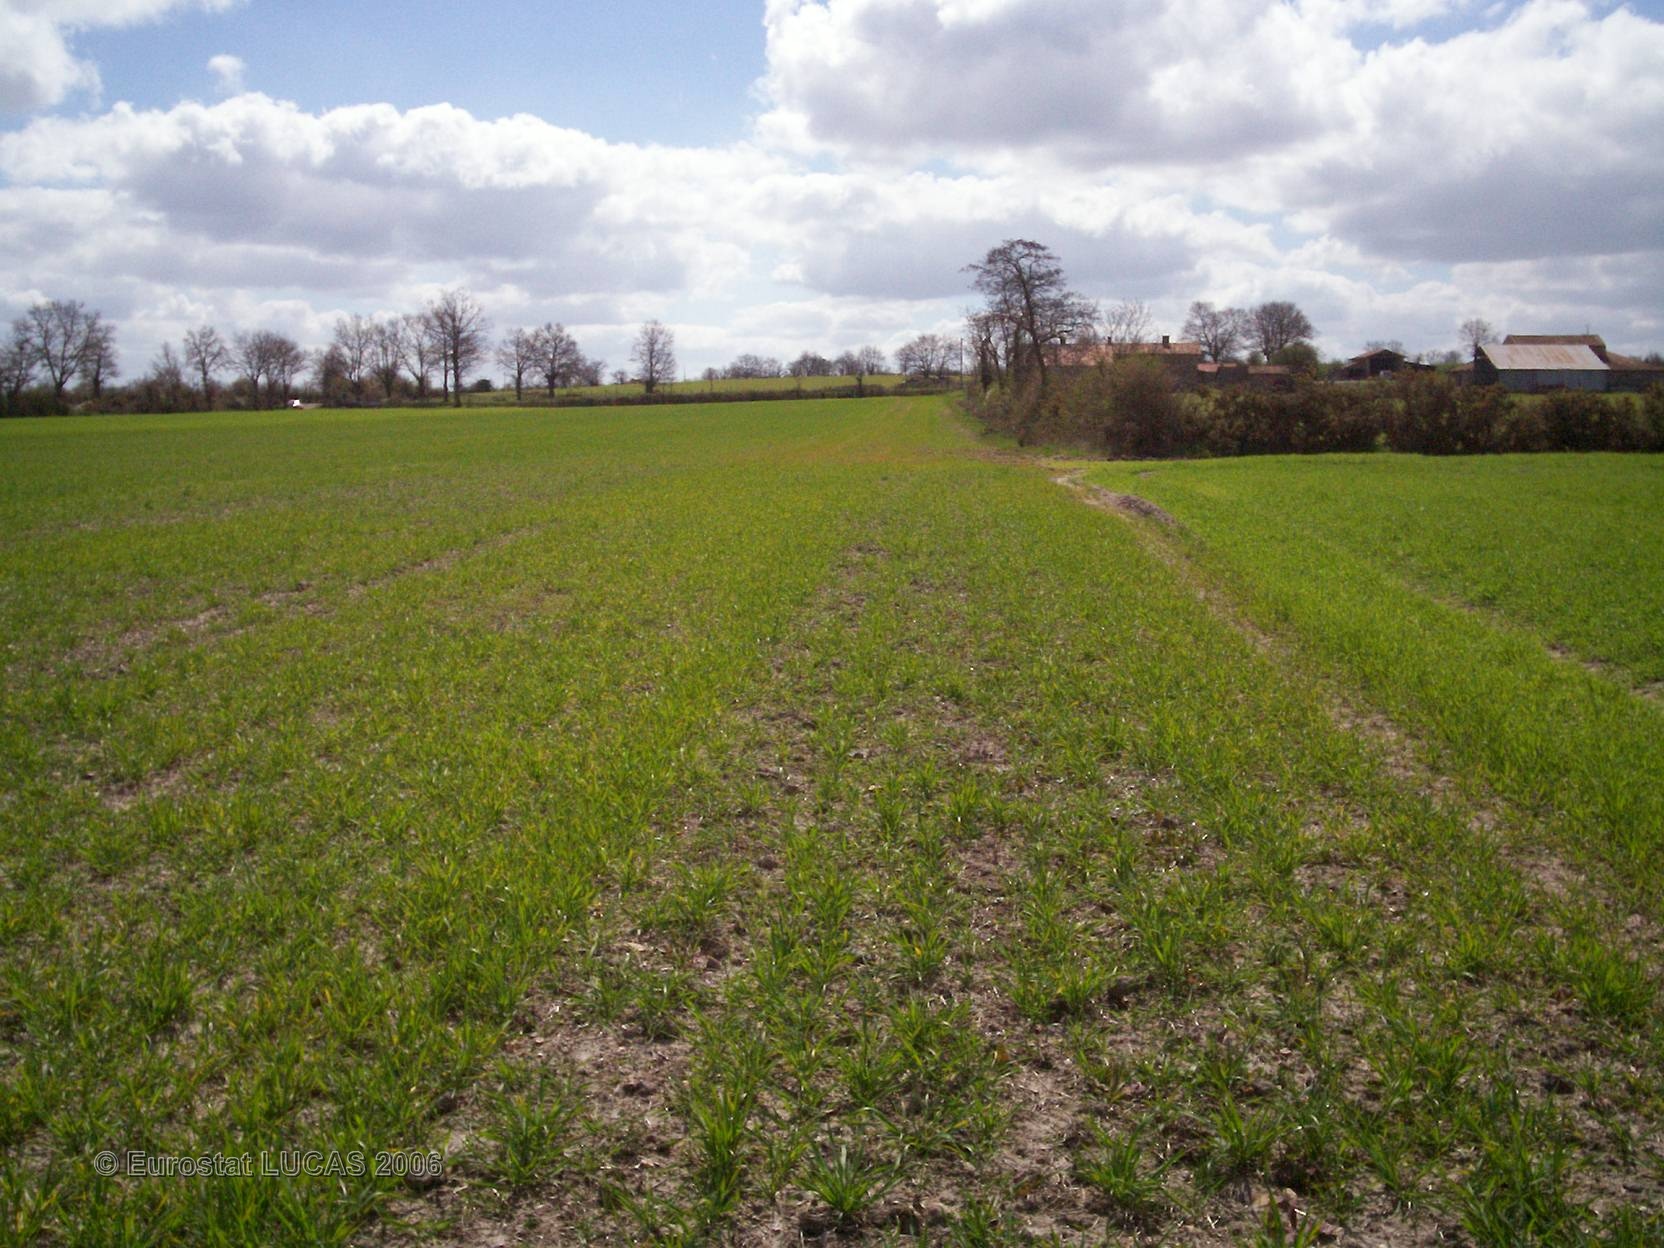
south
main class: Cropland
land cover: Barley
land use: Agriculture (excluding fallow land and kitchen gardens)
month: April
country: FR
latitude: 46.7776
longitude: -0.3070
